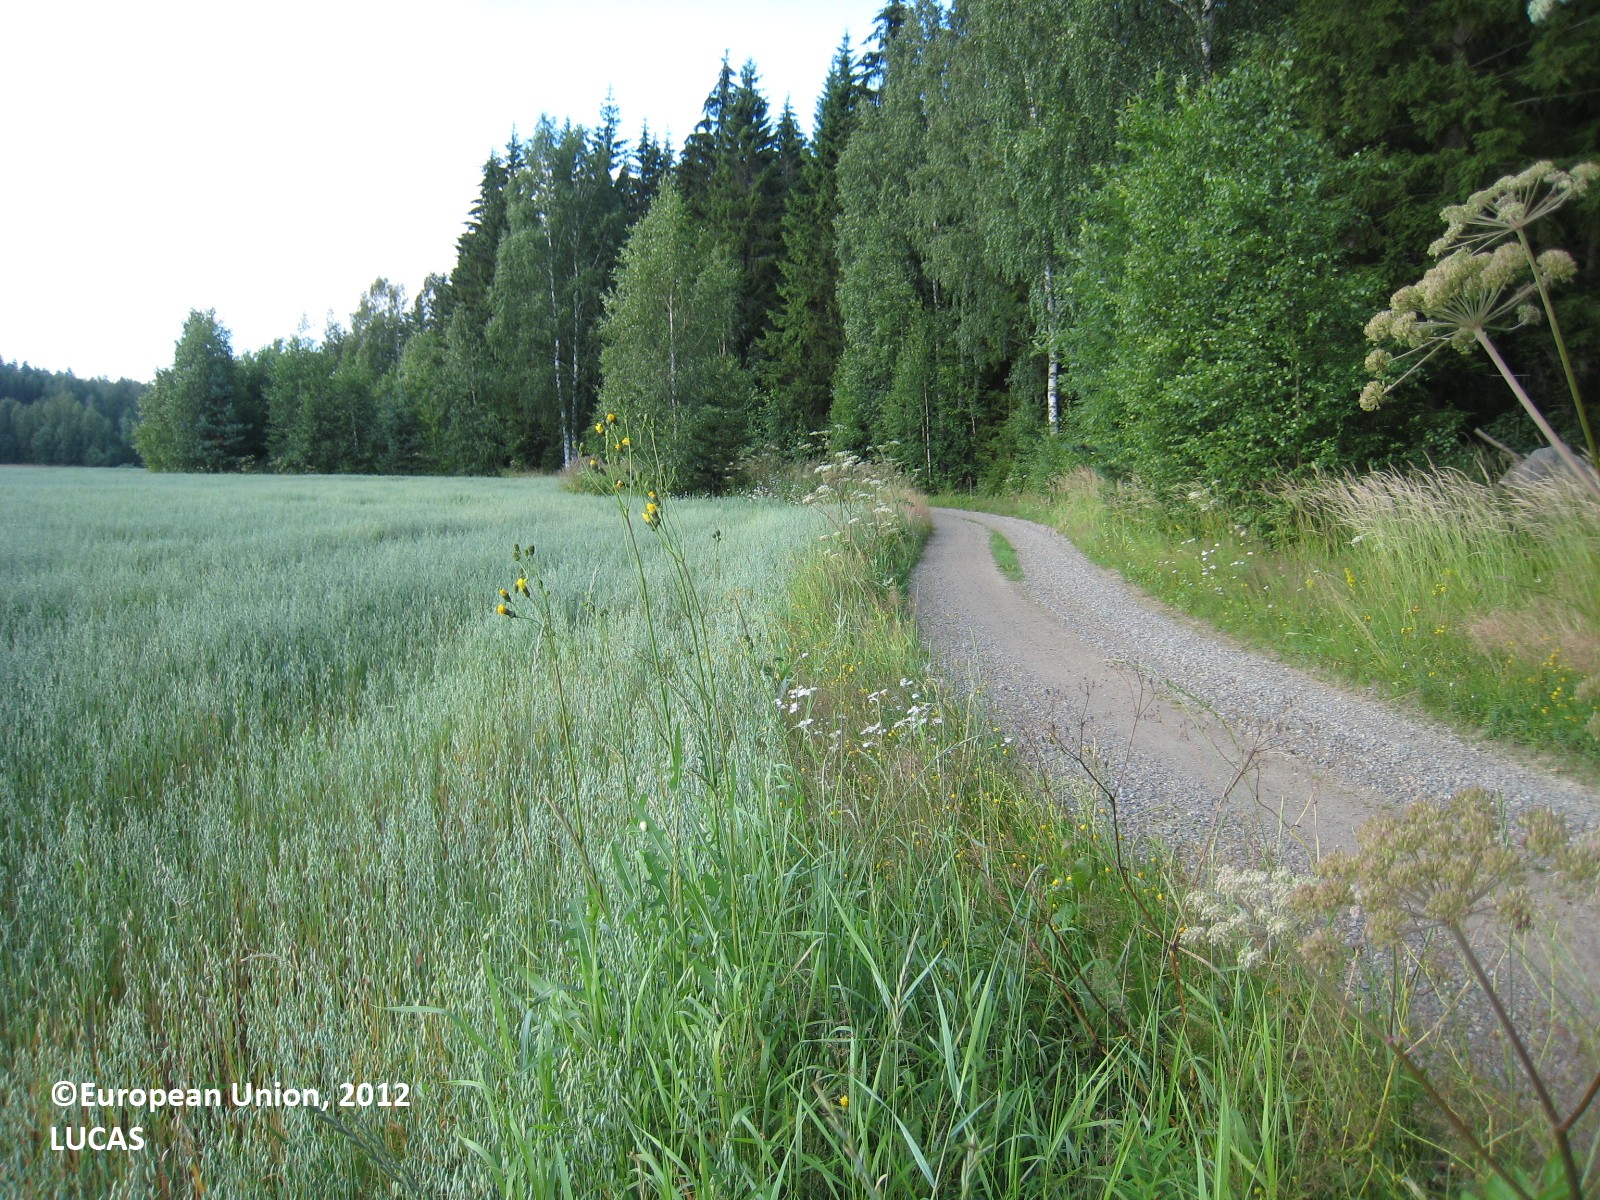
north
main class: Cropland
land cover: Oats
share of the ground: 50 - 75 %
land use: Agriculture (excluding fallow land and kitchen gardens)
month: July
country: FI
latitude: 61.6720
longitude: 26.0201
